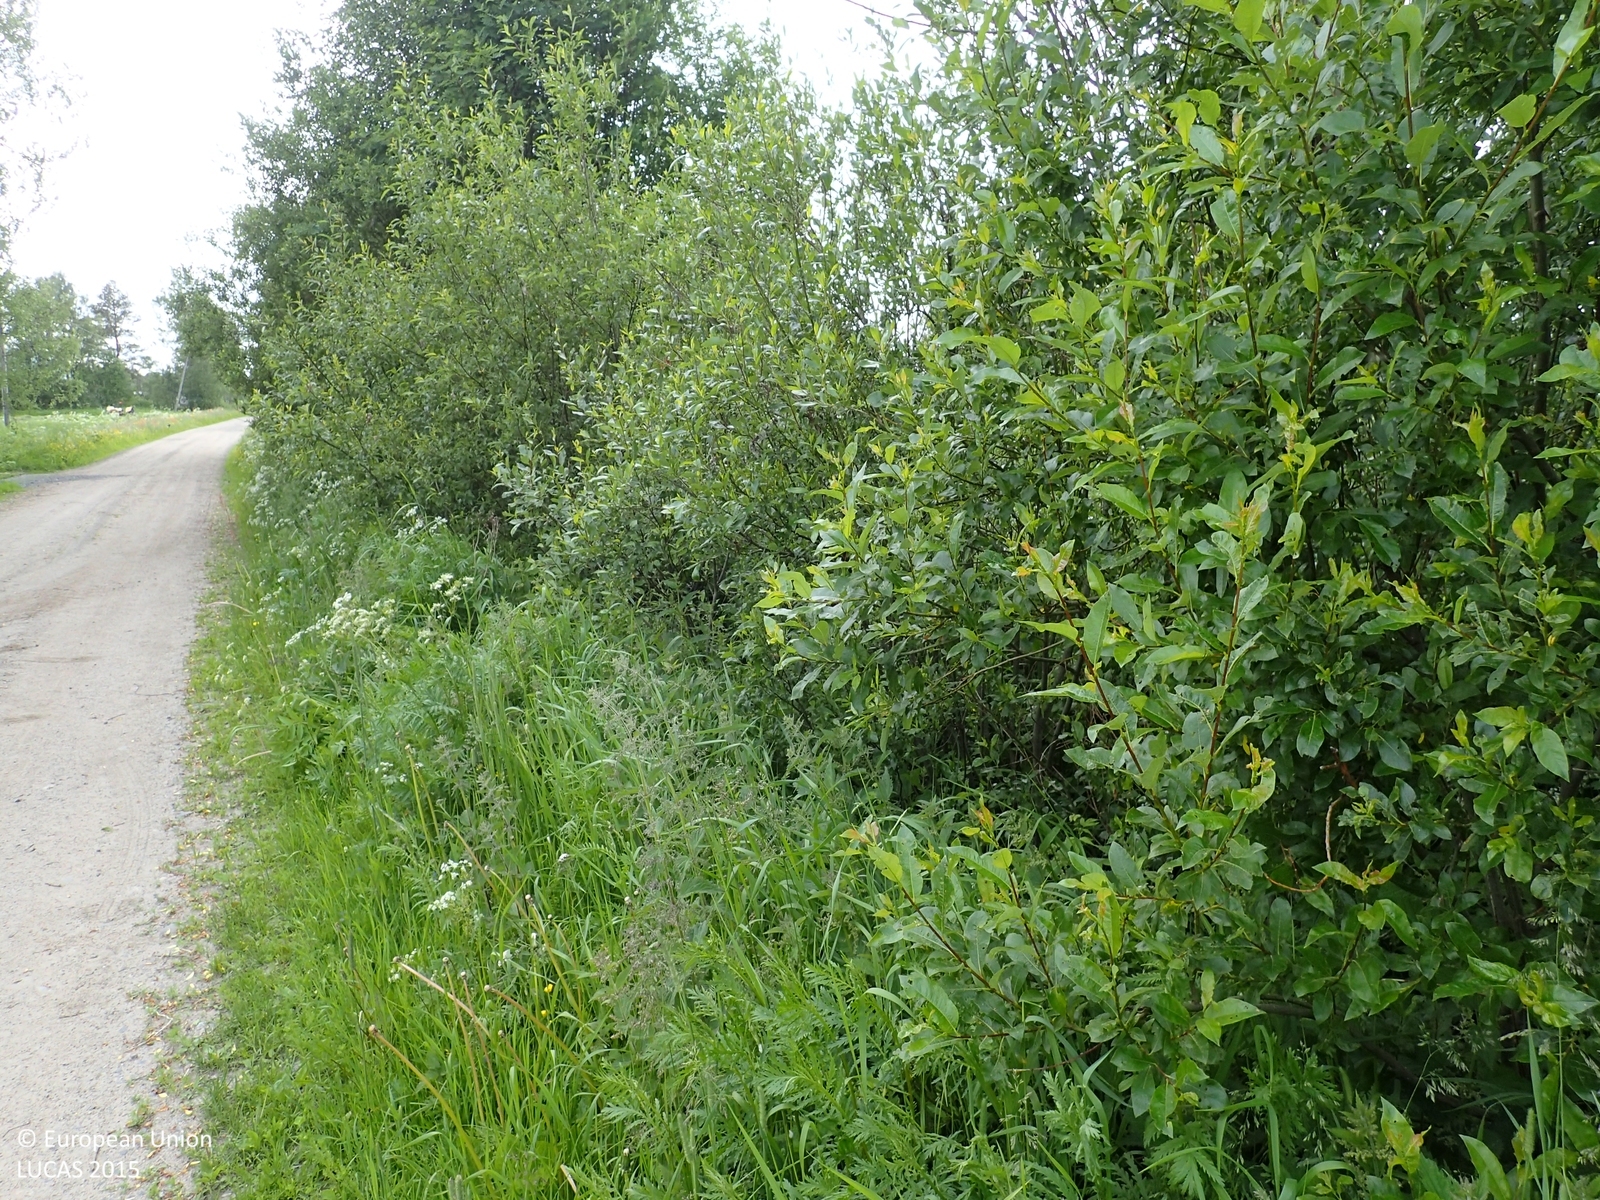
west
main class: Woodland
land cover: Broadleaved woodland
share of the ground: 50 - 75 %
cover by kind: broadleaved forest trees 55 %, herbaceous plants 45 %
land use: Semi-natural and natural areas not in use
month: June
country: FI
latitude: 62.5597
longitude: 21.4211
